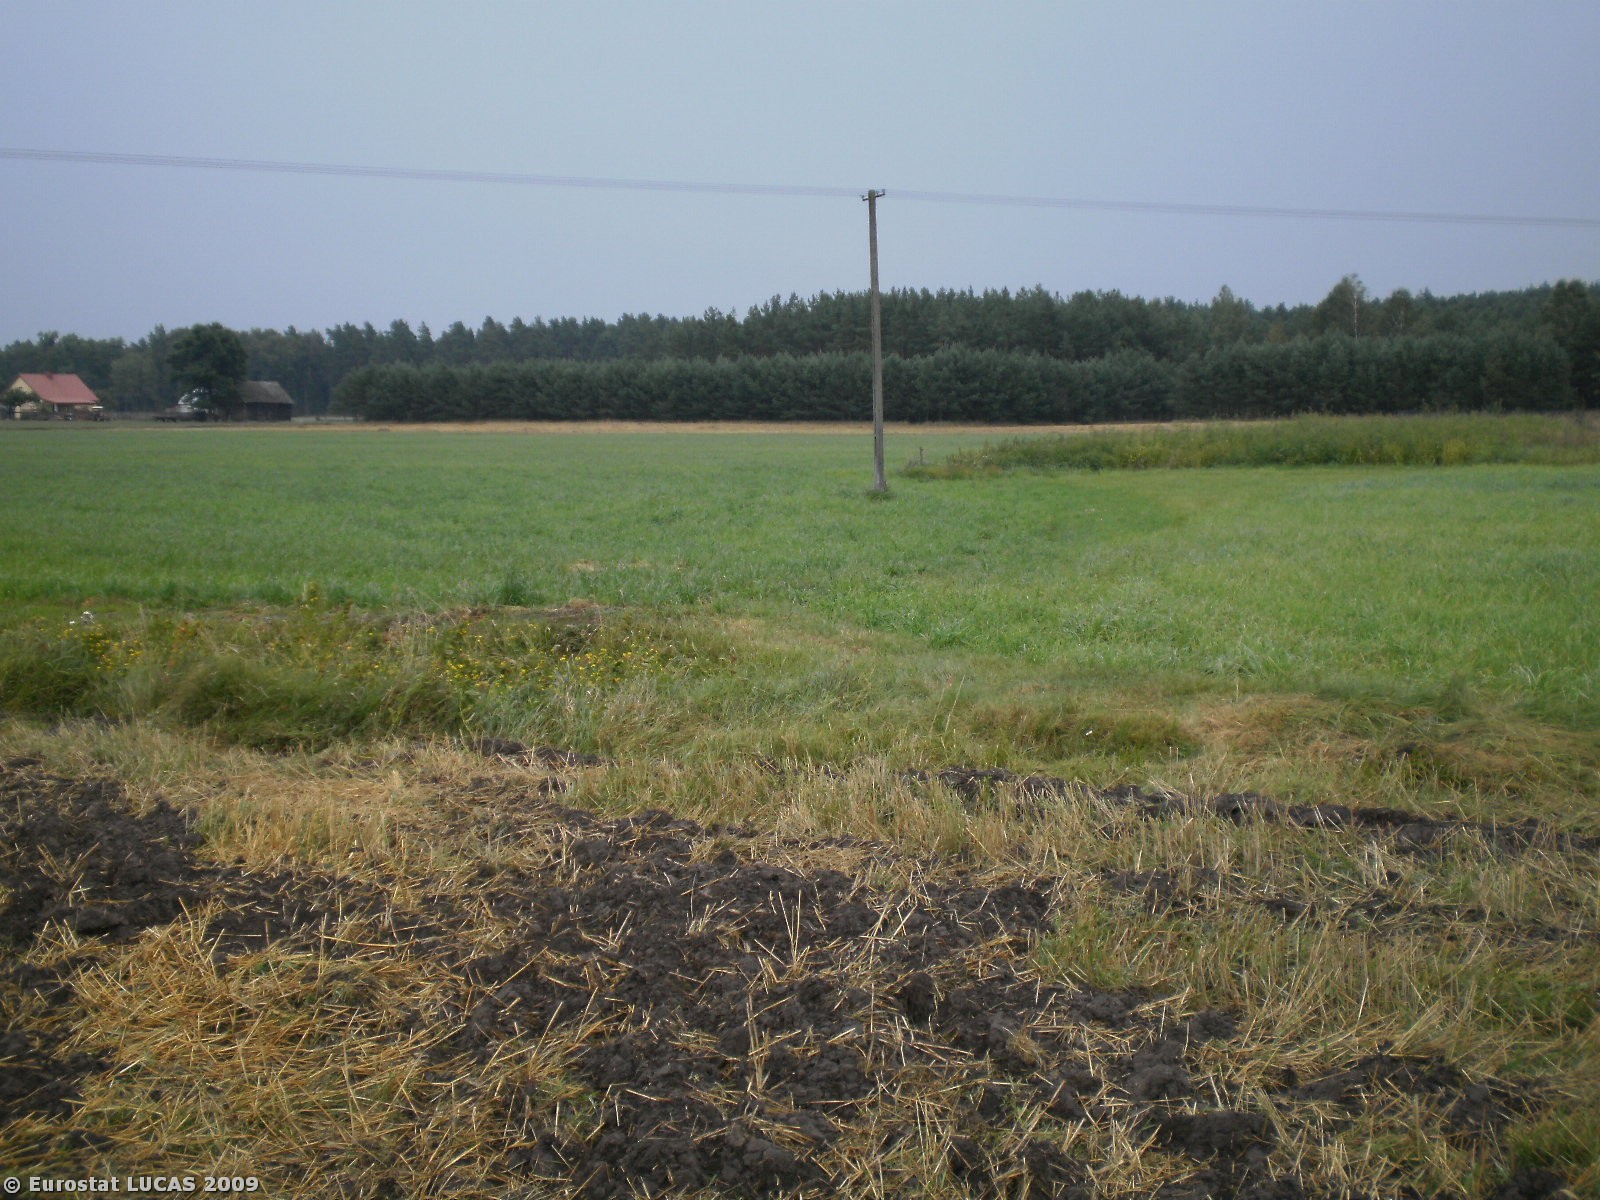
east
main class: Cropland
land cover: Rye
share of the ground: < 10 %
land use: Agriculture (excluding fallow land and kitchen gardens)
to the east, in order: Rye; Grassland without tree/shrub cover; Electric lines; Grassland without tree/shrub cover; Triticale
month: August
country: PL
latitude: 53.3918
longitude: 21.5544
